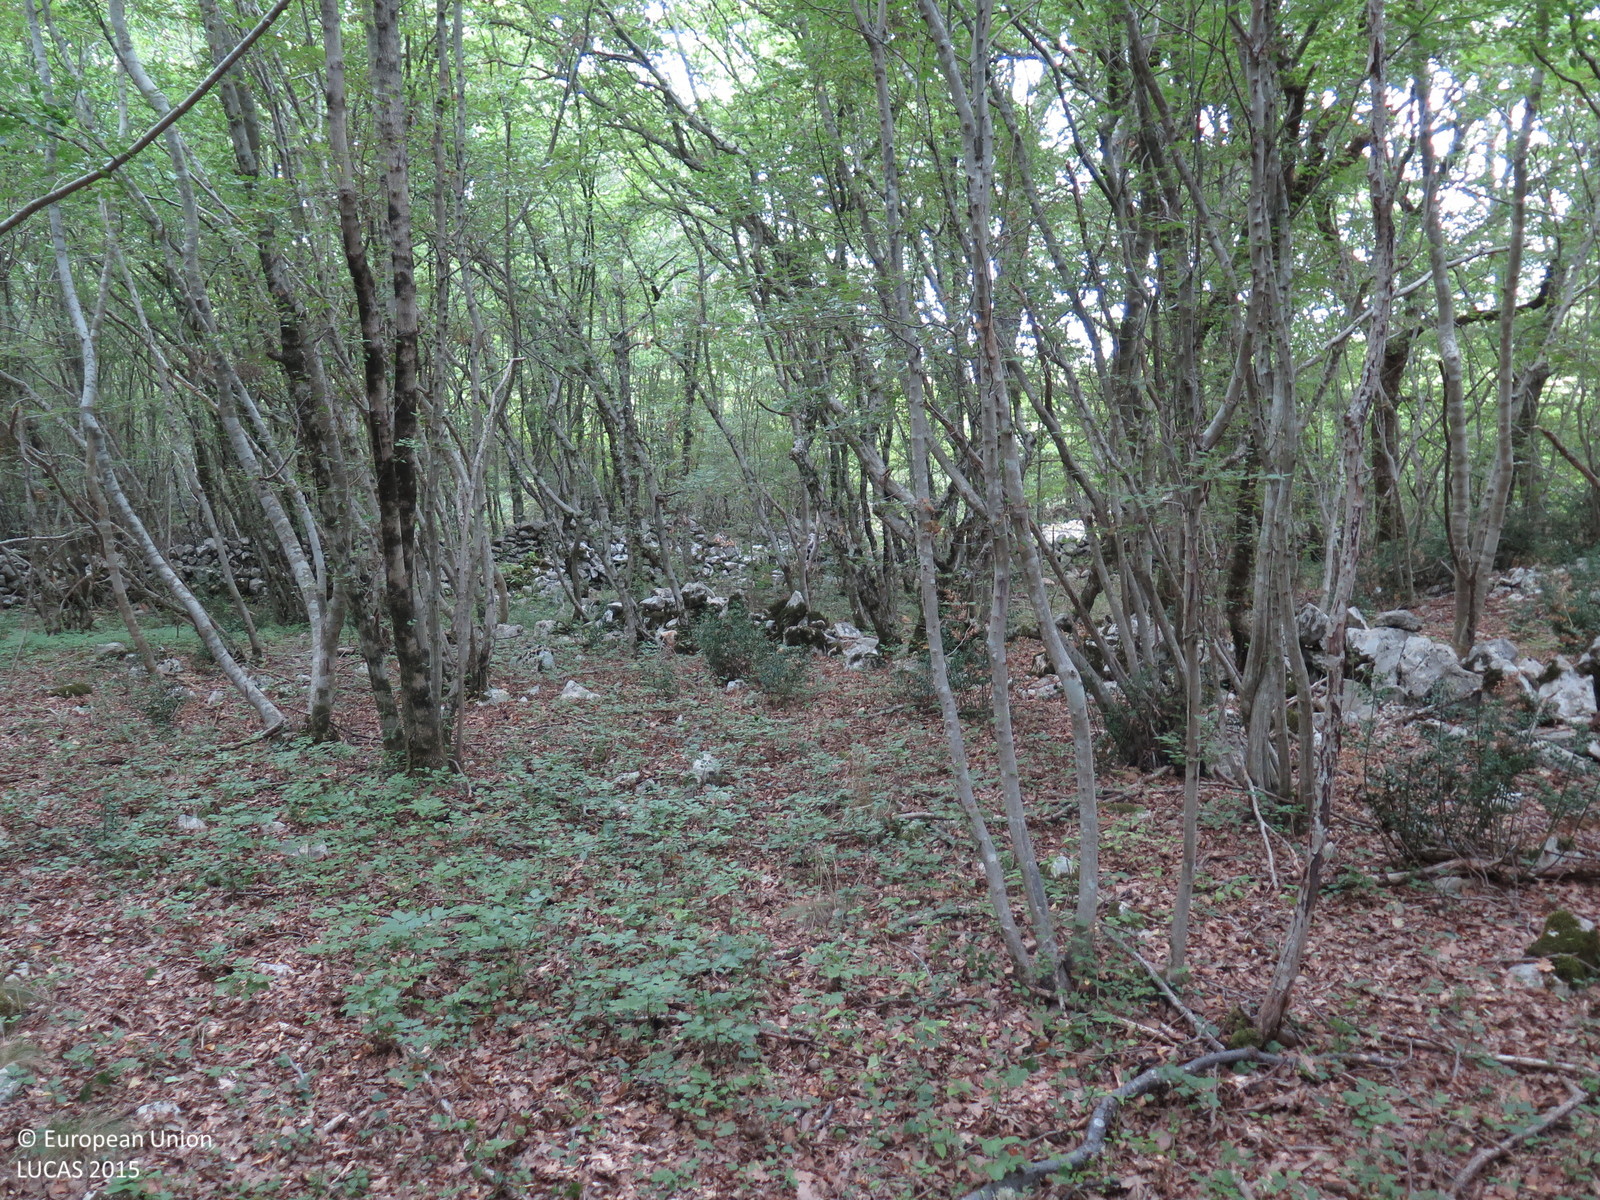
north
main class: Woodland
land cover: Broadleaved woodland
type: beech forest
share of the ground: > 75 %
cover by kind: broadleaved forest trees 100 %
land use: Semi-natural and natural areas not in use
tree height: > 5 m
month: August
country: HR
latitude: 45.1139
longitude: 14.6341
